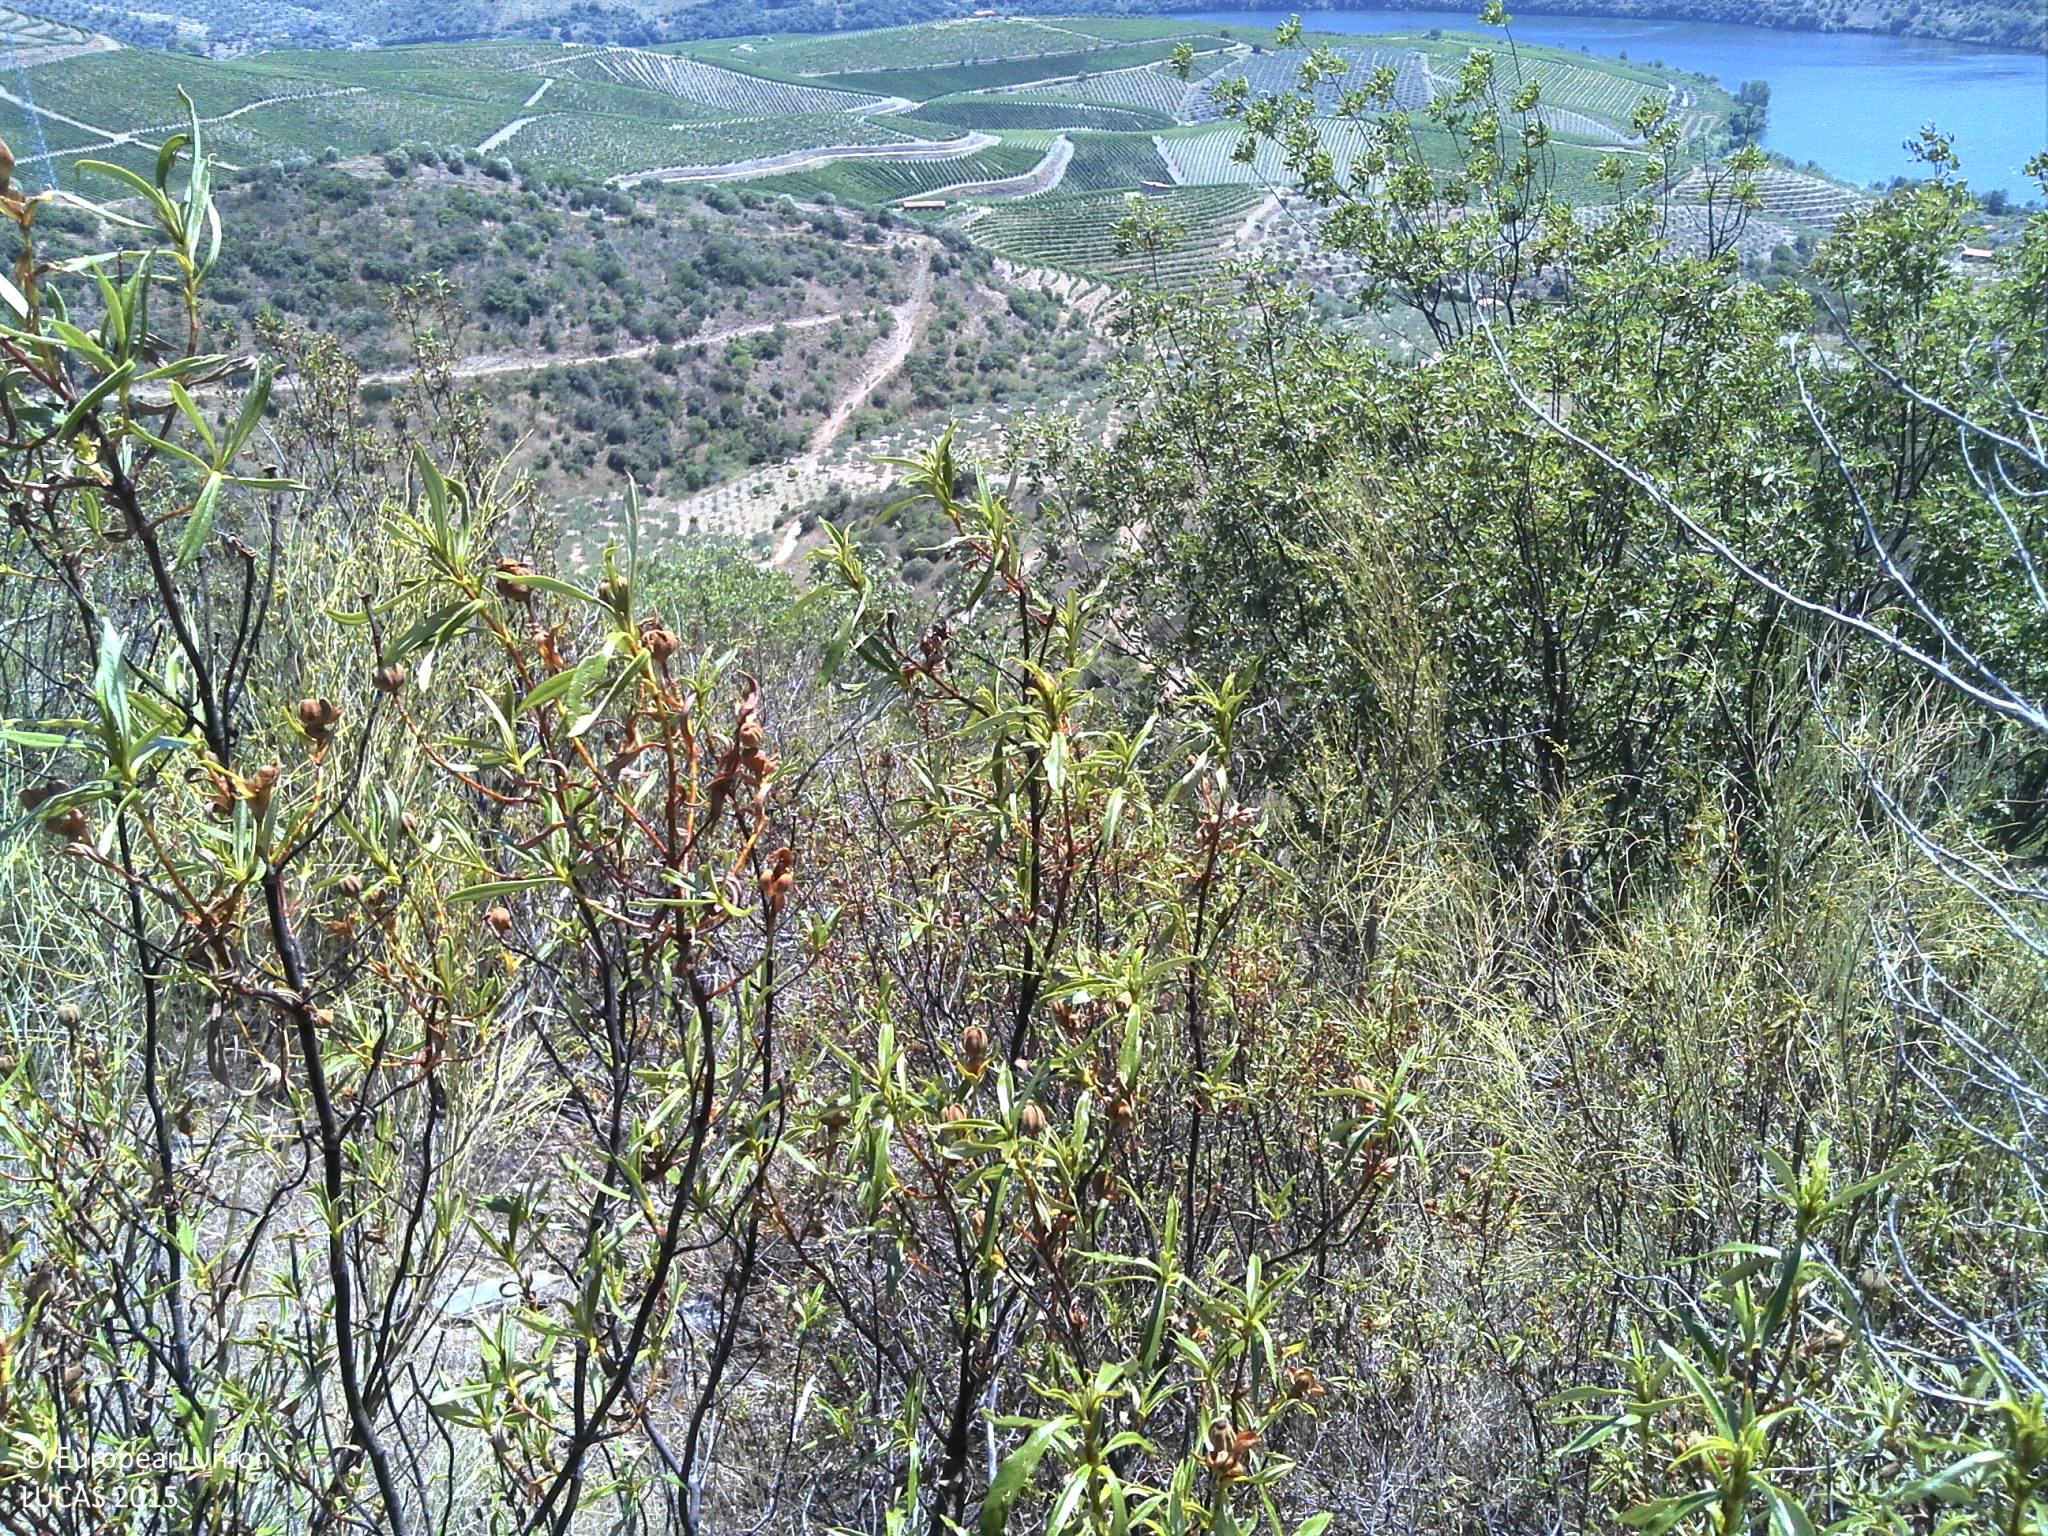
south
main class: Shrubland
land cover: Shrubland without tree cover
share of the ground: > 75 %
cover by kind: shrubs 95 %, unconsolidated bare surface 5 %
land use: Semi-natural and natural areas not in use
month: June
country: PT
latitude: 41.0409
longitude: -6.9874
